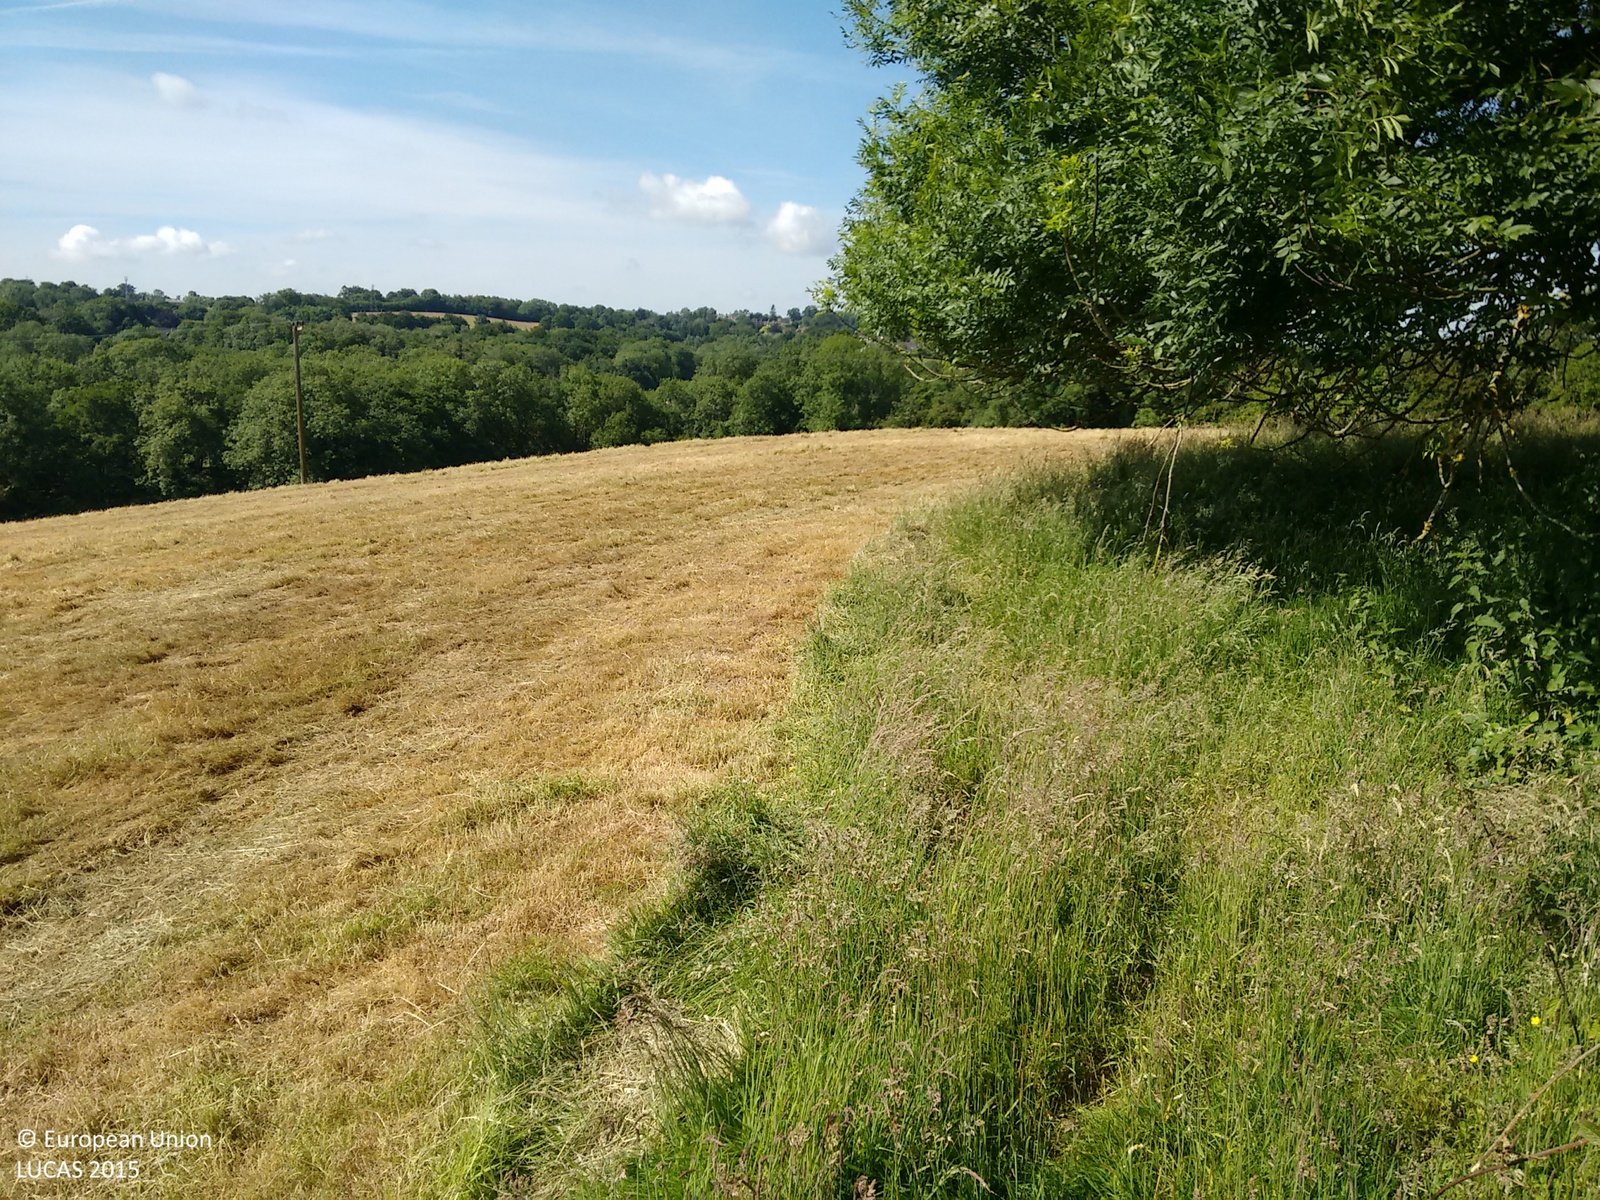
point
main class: Grassland
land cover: Grassland without tree/shrub cover
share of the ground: > 75 %
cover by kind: herbaceous plants 100 %
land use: Agriculture (excluding fallow land and kitchen gardens)
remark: Harvested field
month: June
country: GB
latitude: 51.1141
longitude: -0.0759
